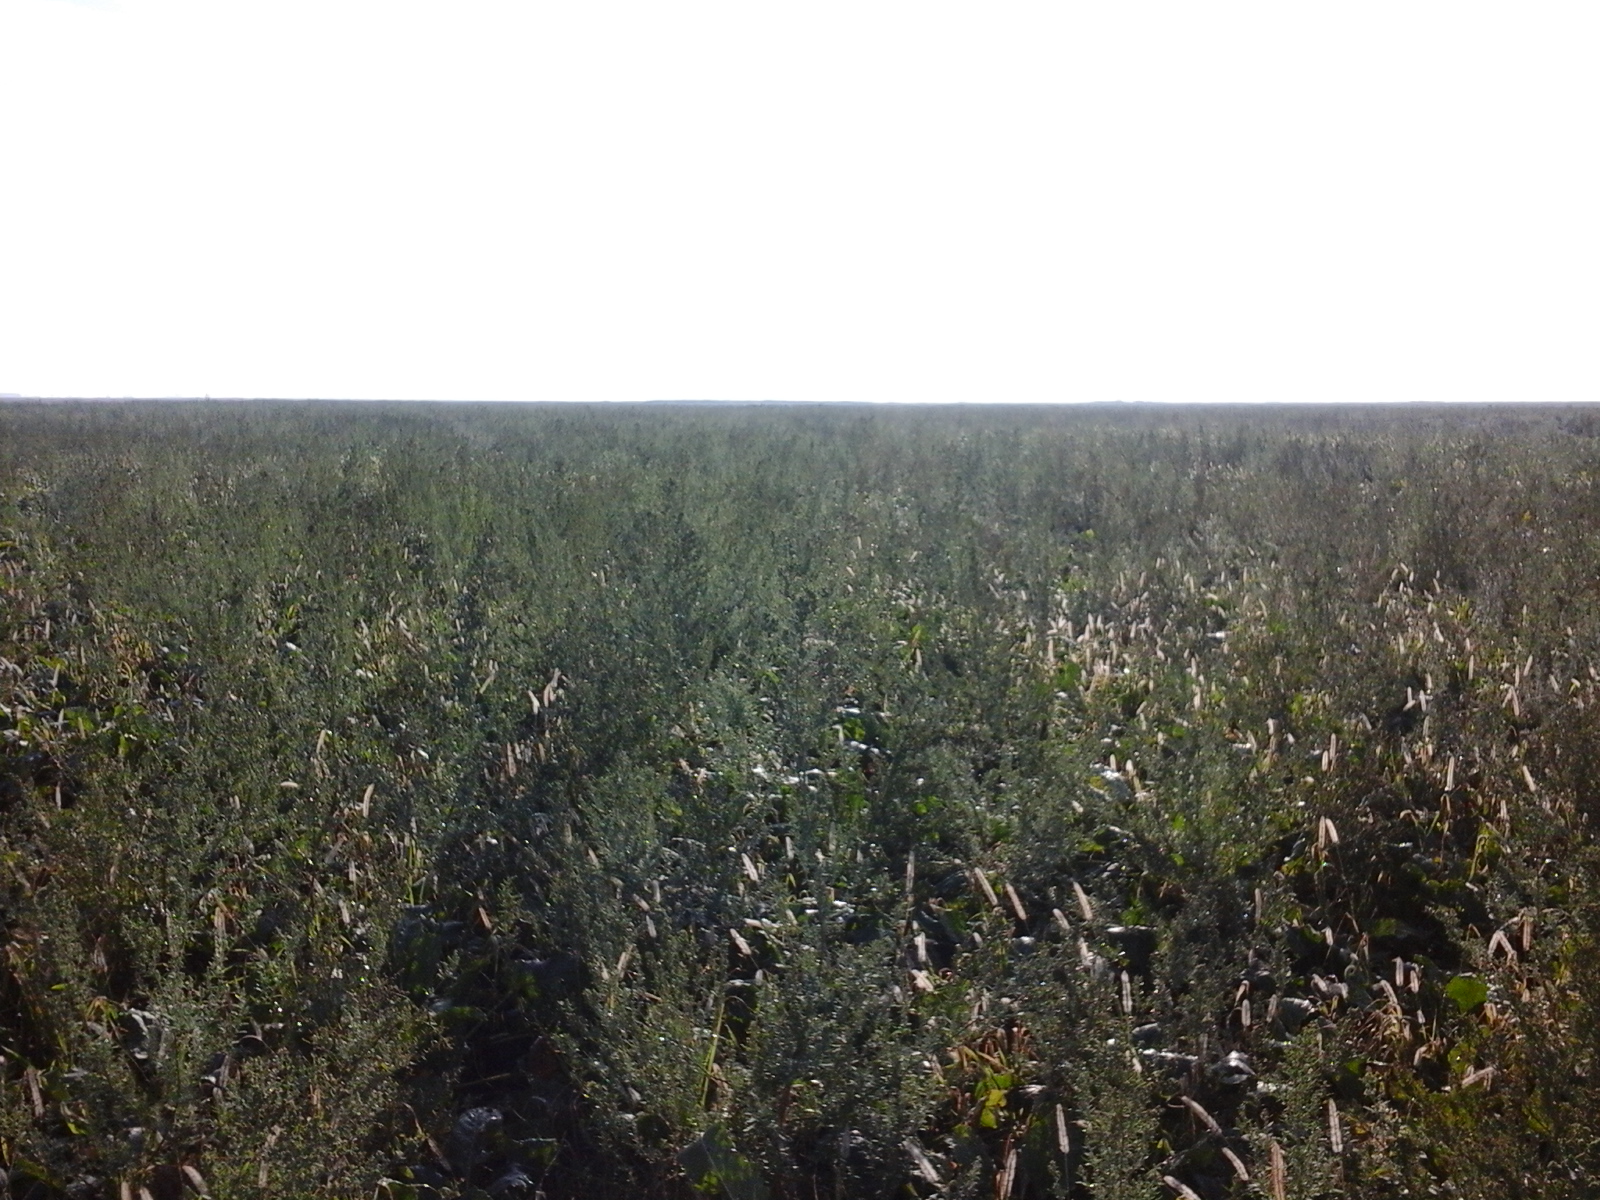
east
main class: Cropland
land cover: Sugar beet
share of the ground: 10 - 25 %
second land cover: Spontaneously vegetated surfaces
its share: > 75 %
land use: Agriculture (excluding fallow land and kitchen gardens)
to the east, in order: Sugar beet; Spontaneously vegetated surfaces
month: August
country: RO
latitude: 45.7946
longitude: 21.0541
